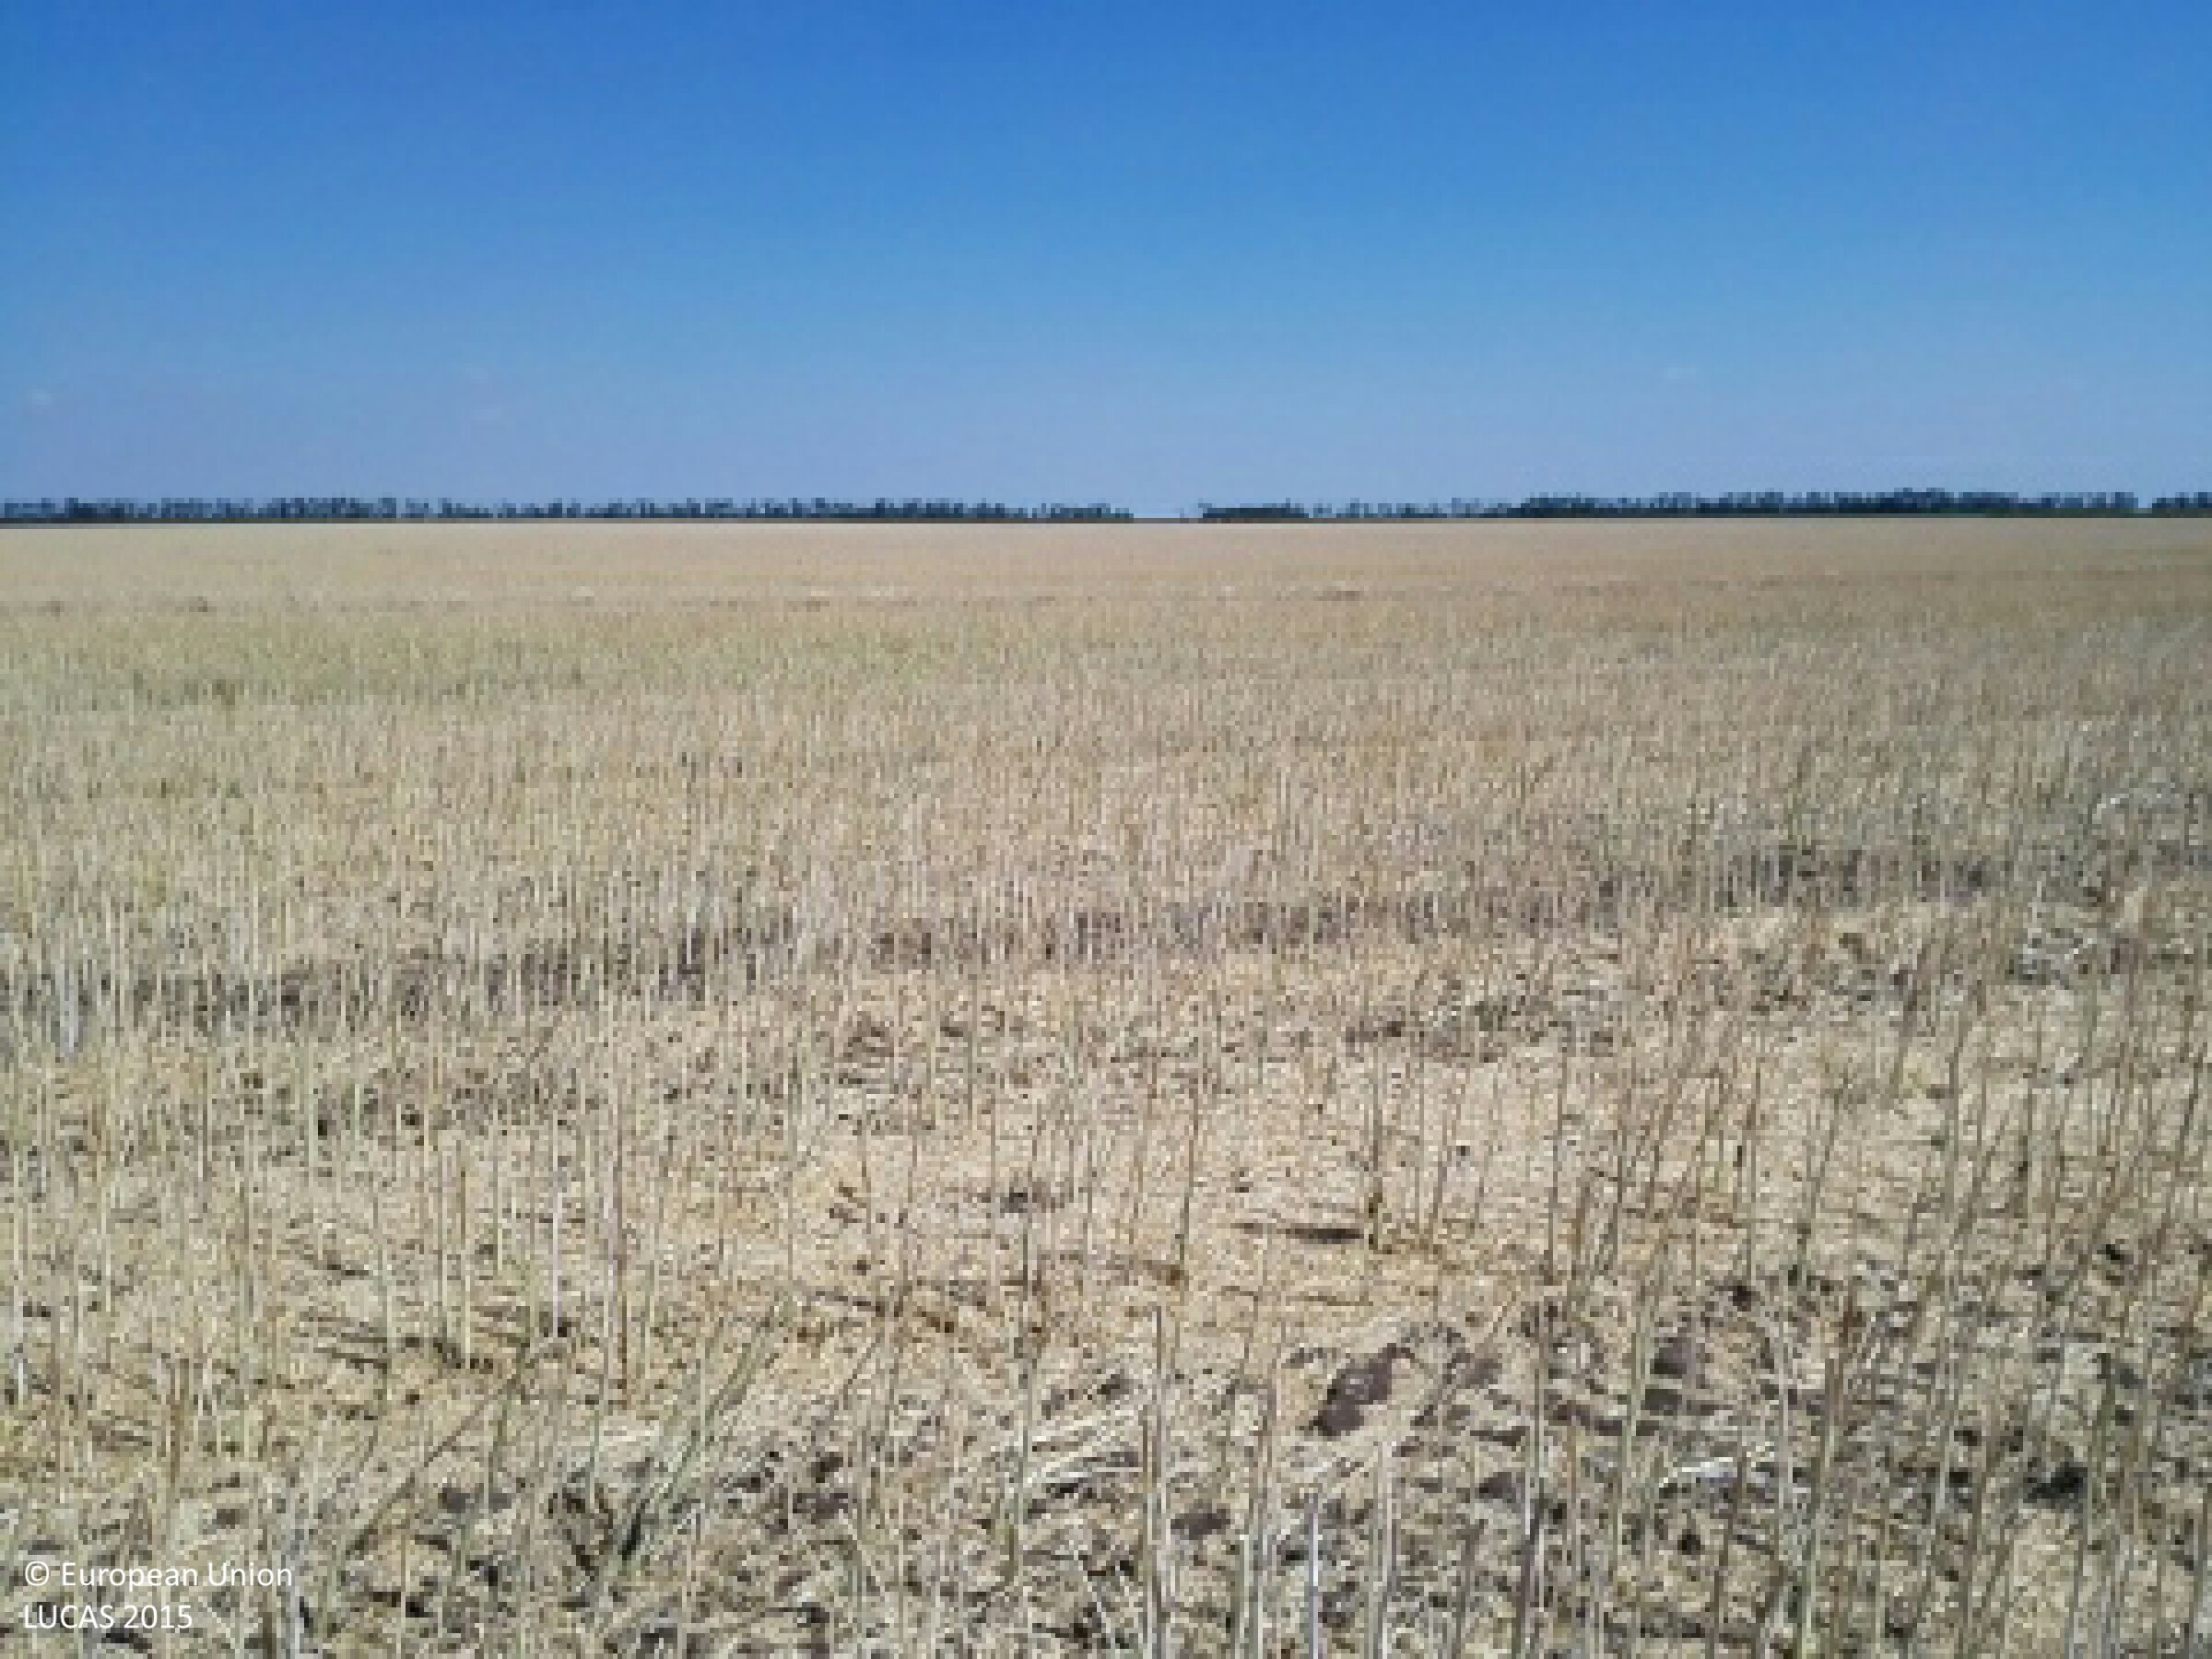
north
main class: Cropland
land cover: Rape and turnip rape
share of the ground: > 75 %
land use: Agriculture (excluding fallow land and kitchen gardens)
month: July
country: HU
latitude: 47.7522
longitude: 21.4482
